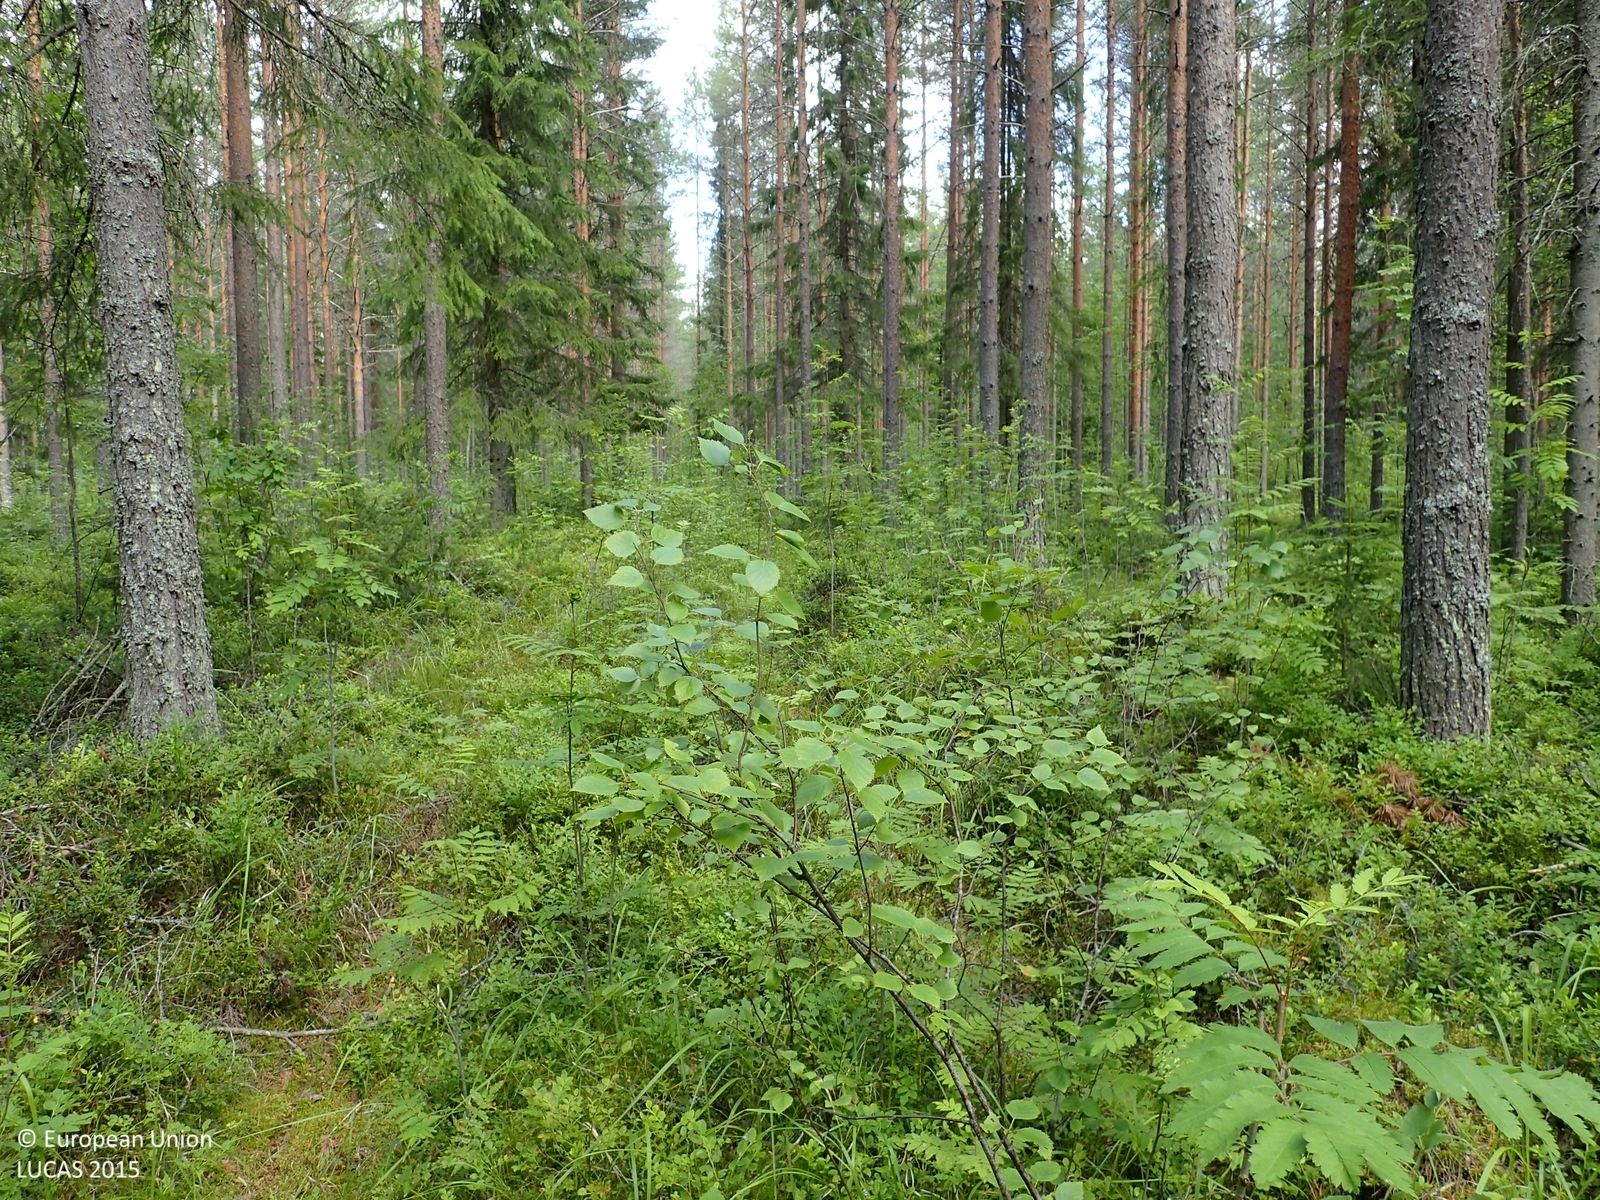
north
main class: Woodland
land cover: Pine dominated coniferous woodland
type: boreal forest
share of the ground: 50 - 75 %
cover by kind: coniferous forest trees 55 %, shrubs 30 %, broadleaved forest trees 10 %, herbaceous plants 5 %
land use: Forestry
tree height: > 5 m
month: July
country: FI
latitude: 62.7654
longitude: 23.5651
